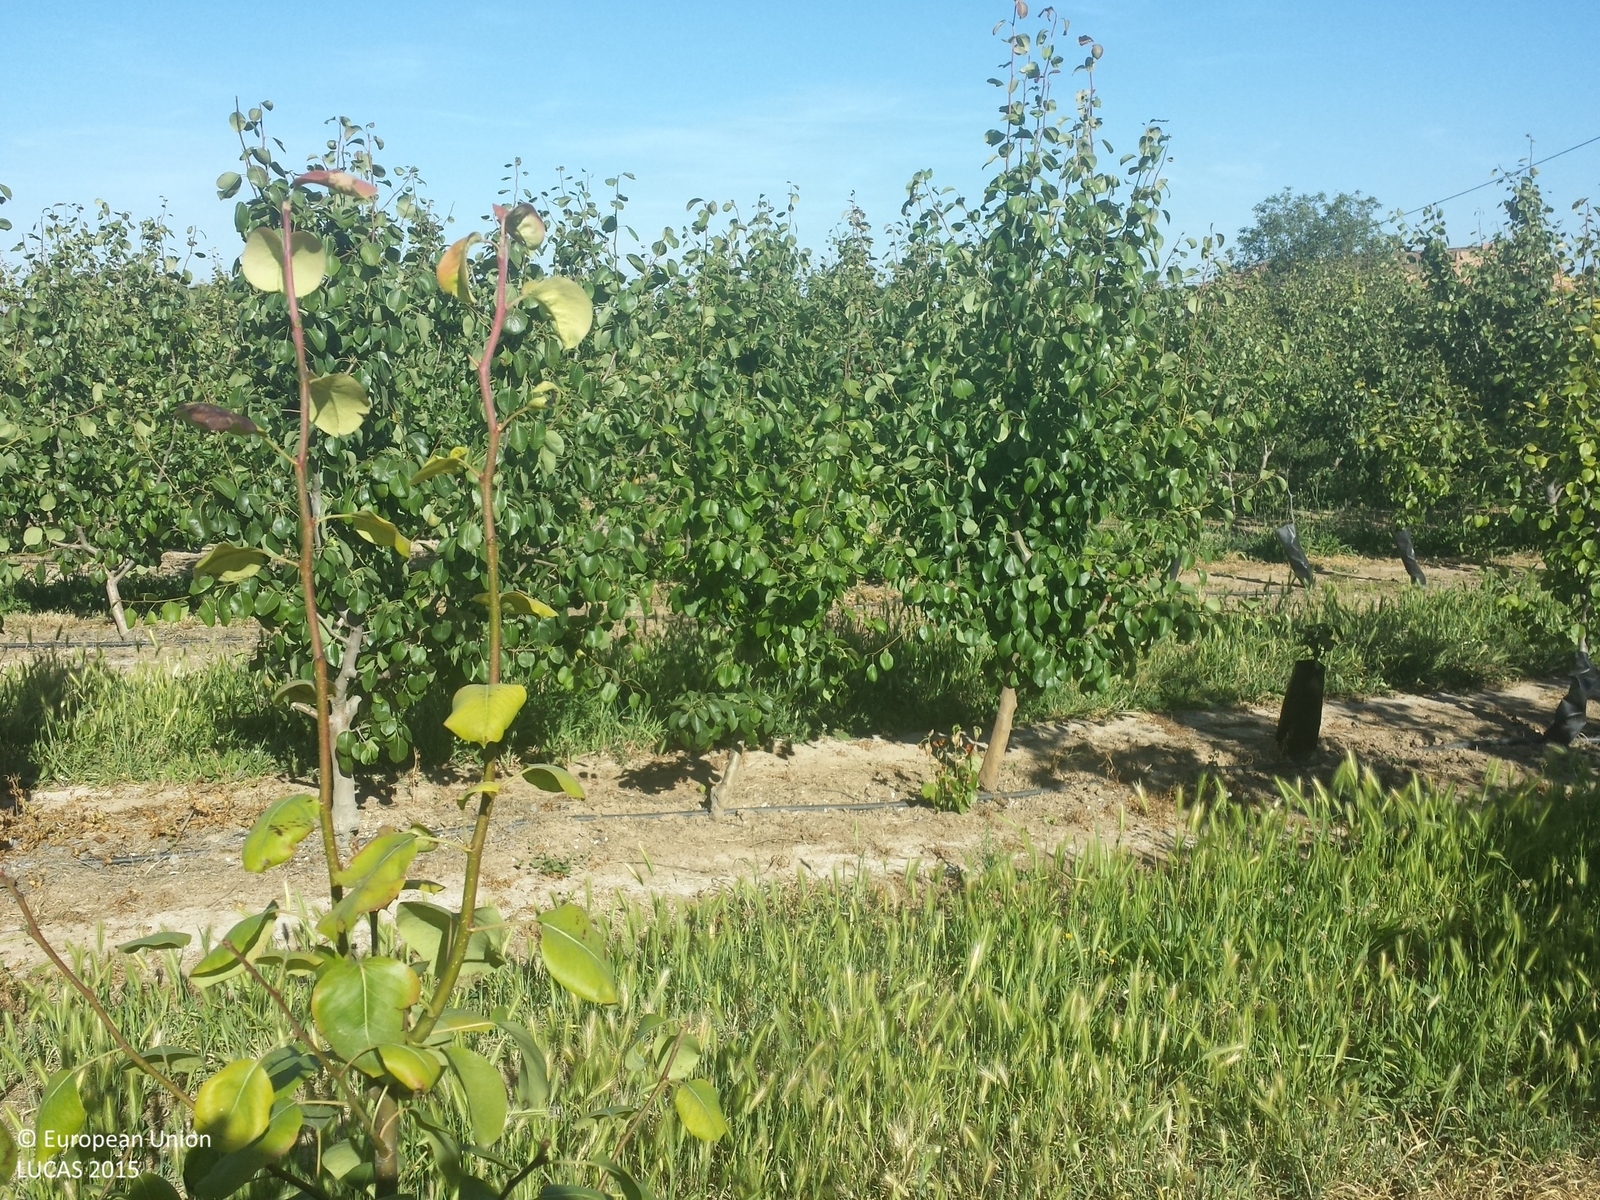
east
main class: Cropland
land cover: Pear fruit
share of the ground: 25 - 50 %
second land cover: Grassland without tree/shrub cover
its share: 50 - 75 %
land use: Agriculture (excluding fallow land and kitchen gardens)
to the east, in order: Pear fruit; Grassland without tree/shrub cover; Paved roads, cycling and walking lanes; Pear fruit; Electric lines; Other bare soil; Artificial constructions in urban areas; Pine dominated coniferous woodland; Grassland with sparse tree/shrub cover; Groves; Tracks; Arable land (only in case pi); Permanent crops (only in case pi)
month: May
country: ES
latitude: 41.6512
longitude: 0.5854
